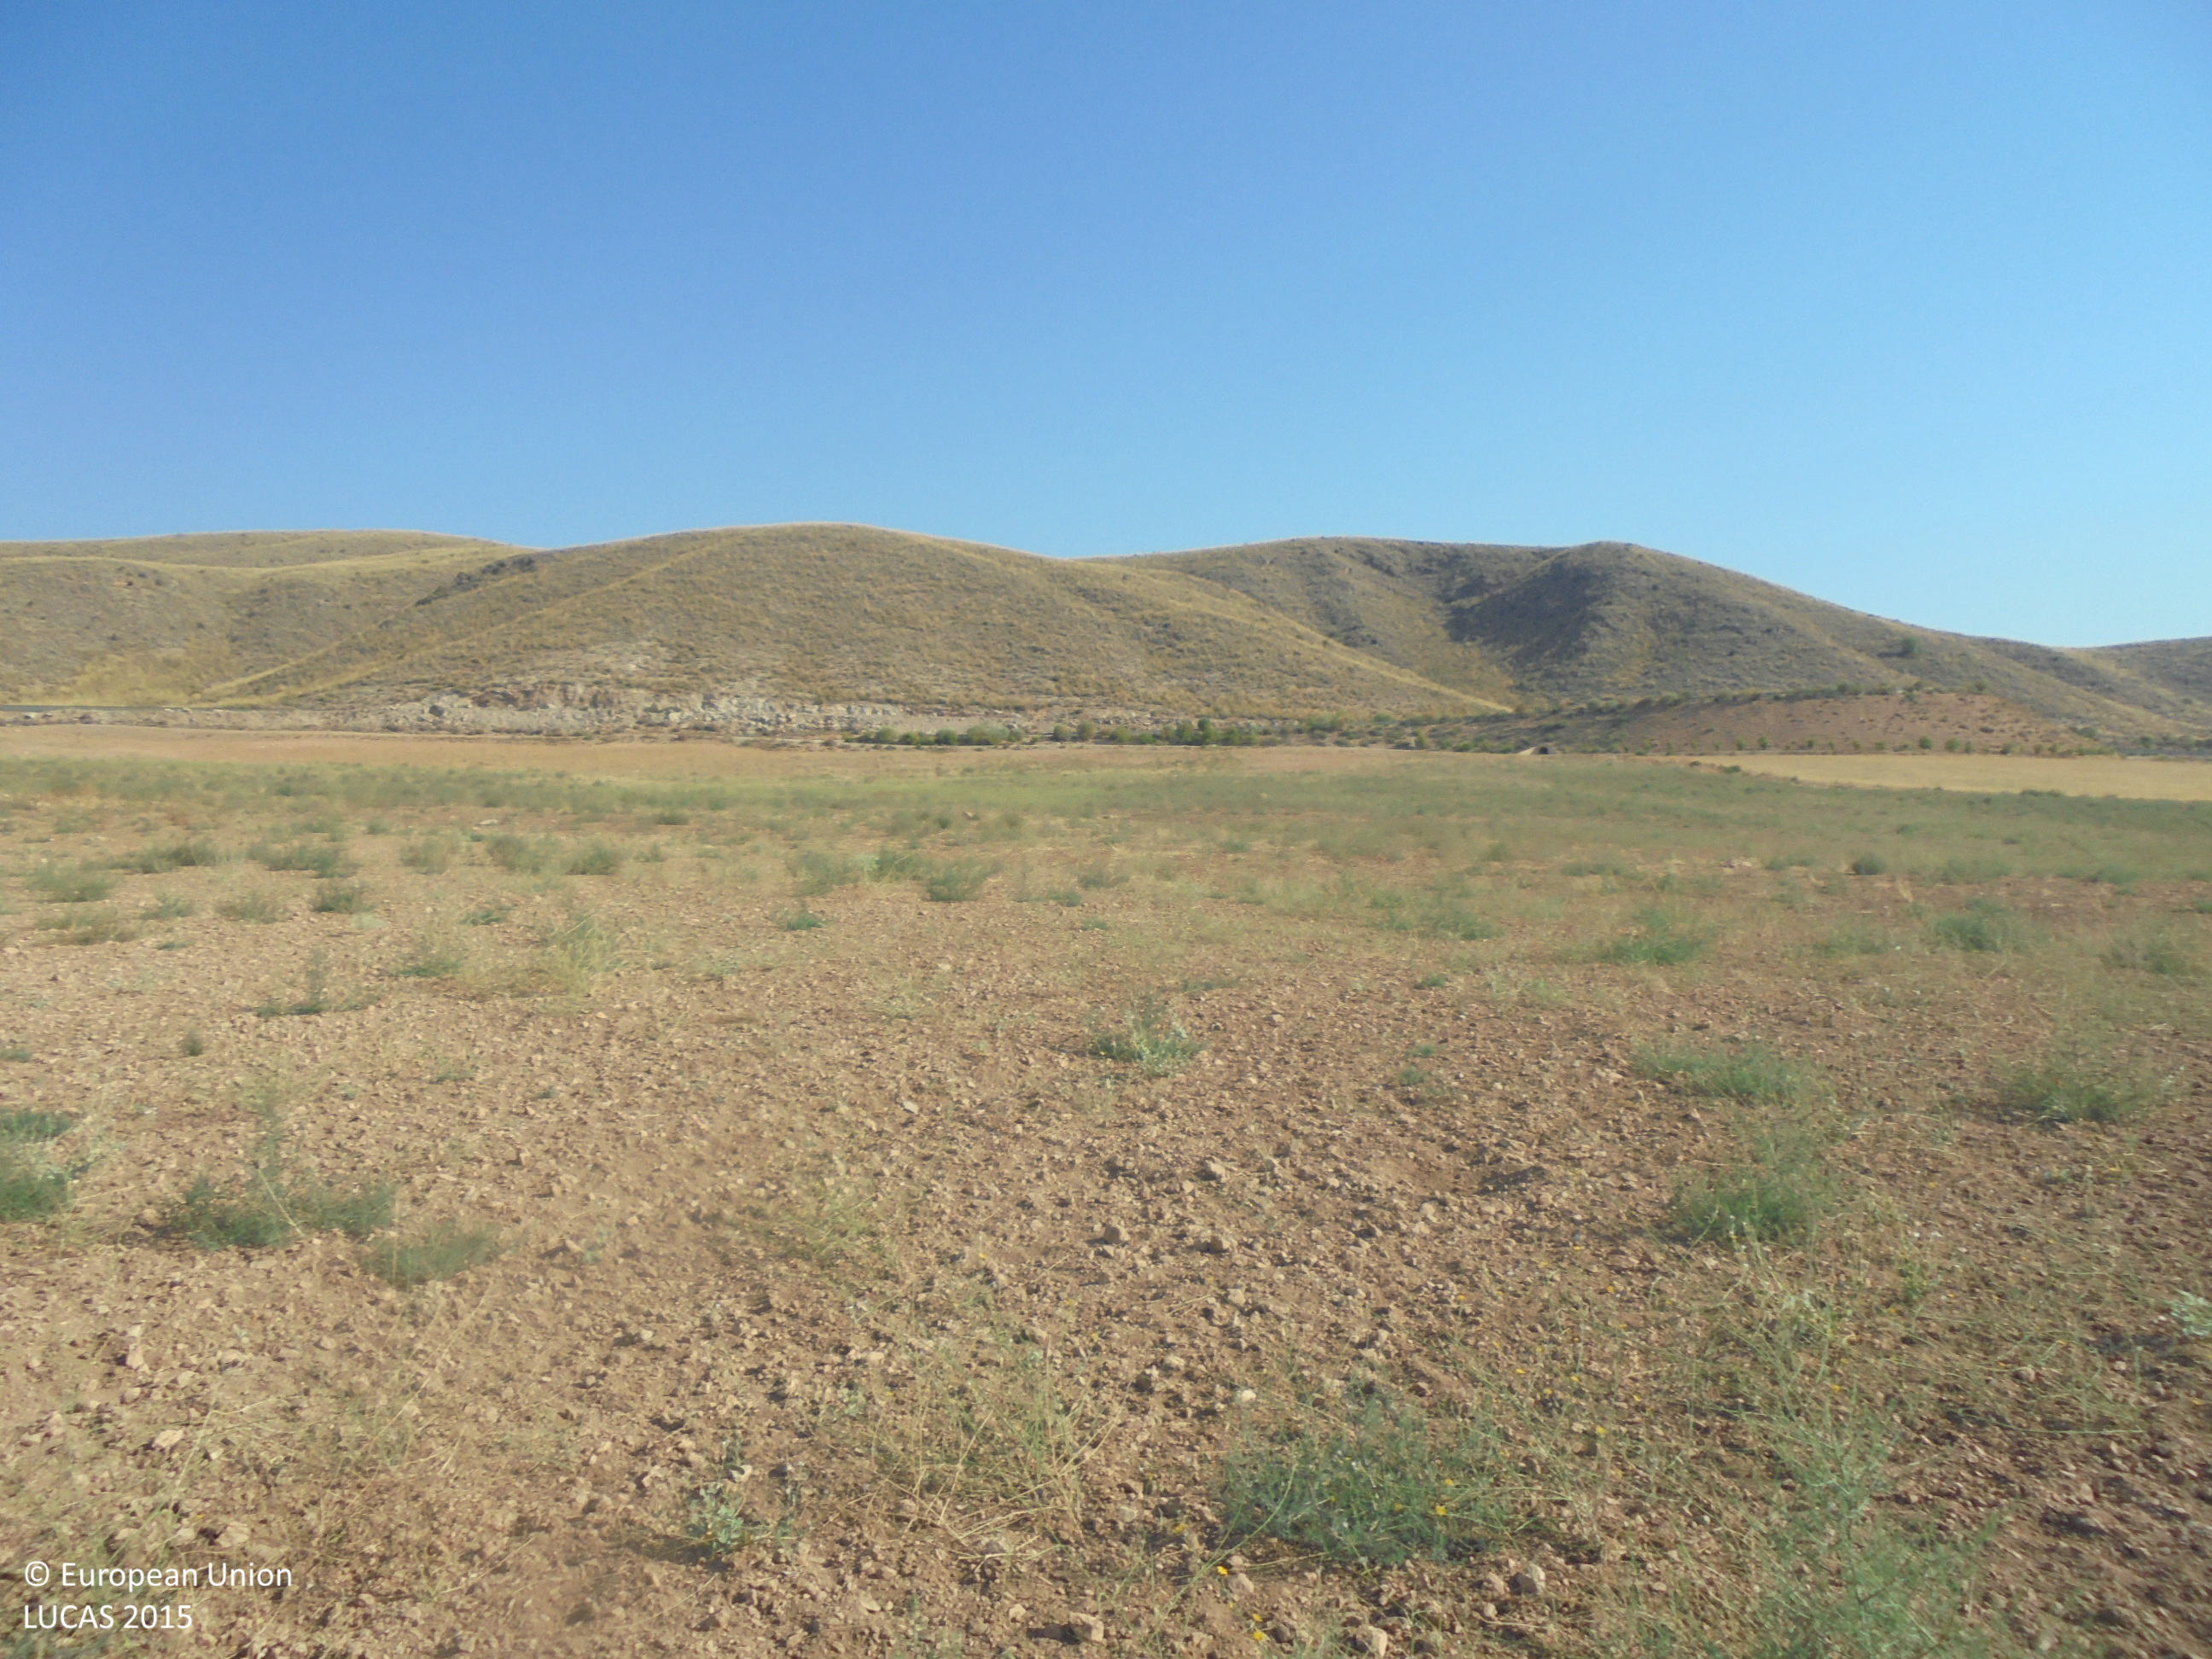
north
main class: Grassland
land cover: Spontaneously vegetated surfaces
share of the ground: 10 - 25 %
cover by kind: unconsolidated bare surface 80 %, herbaceous plants 20 %
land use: Agriculture (excluding fallow land and kitchen gardens)
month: July
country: ES
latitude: 38.5102
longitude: -1.6560
